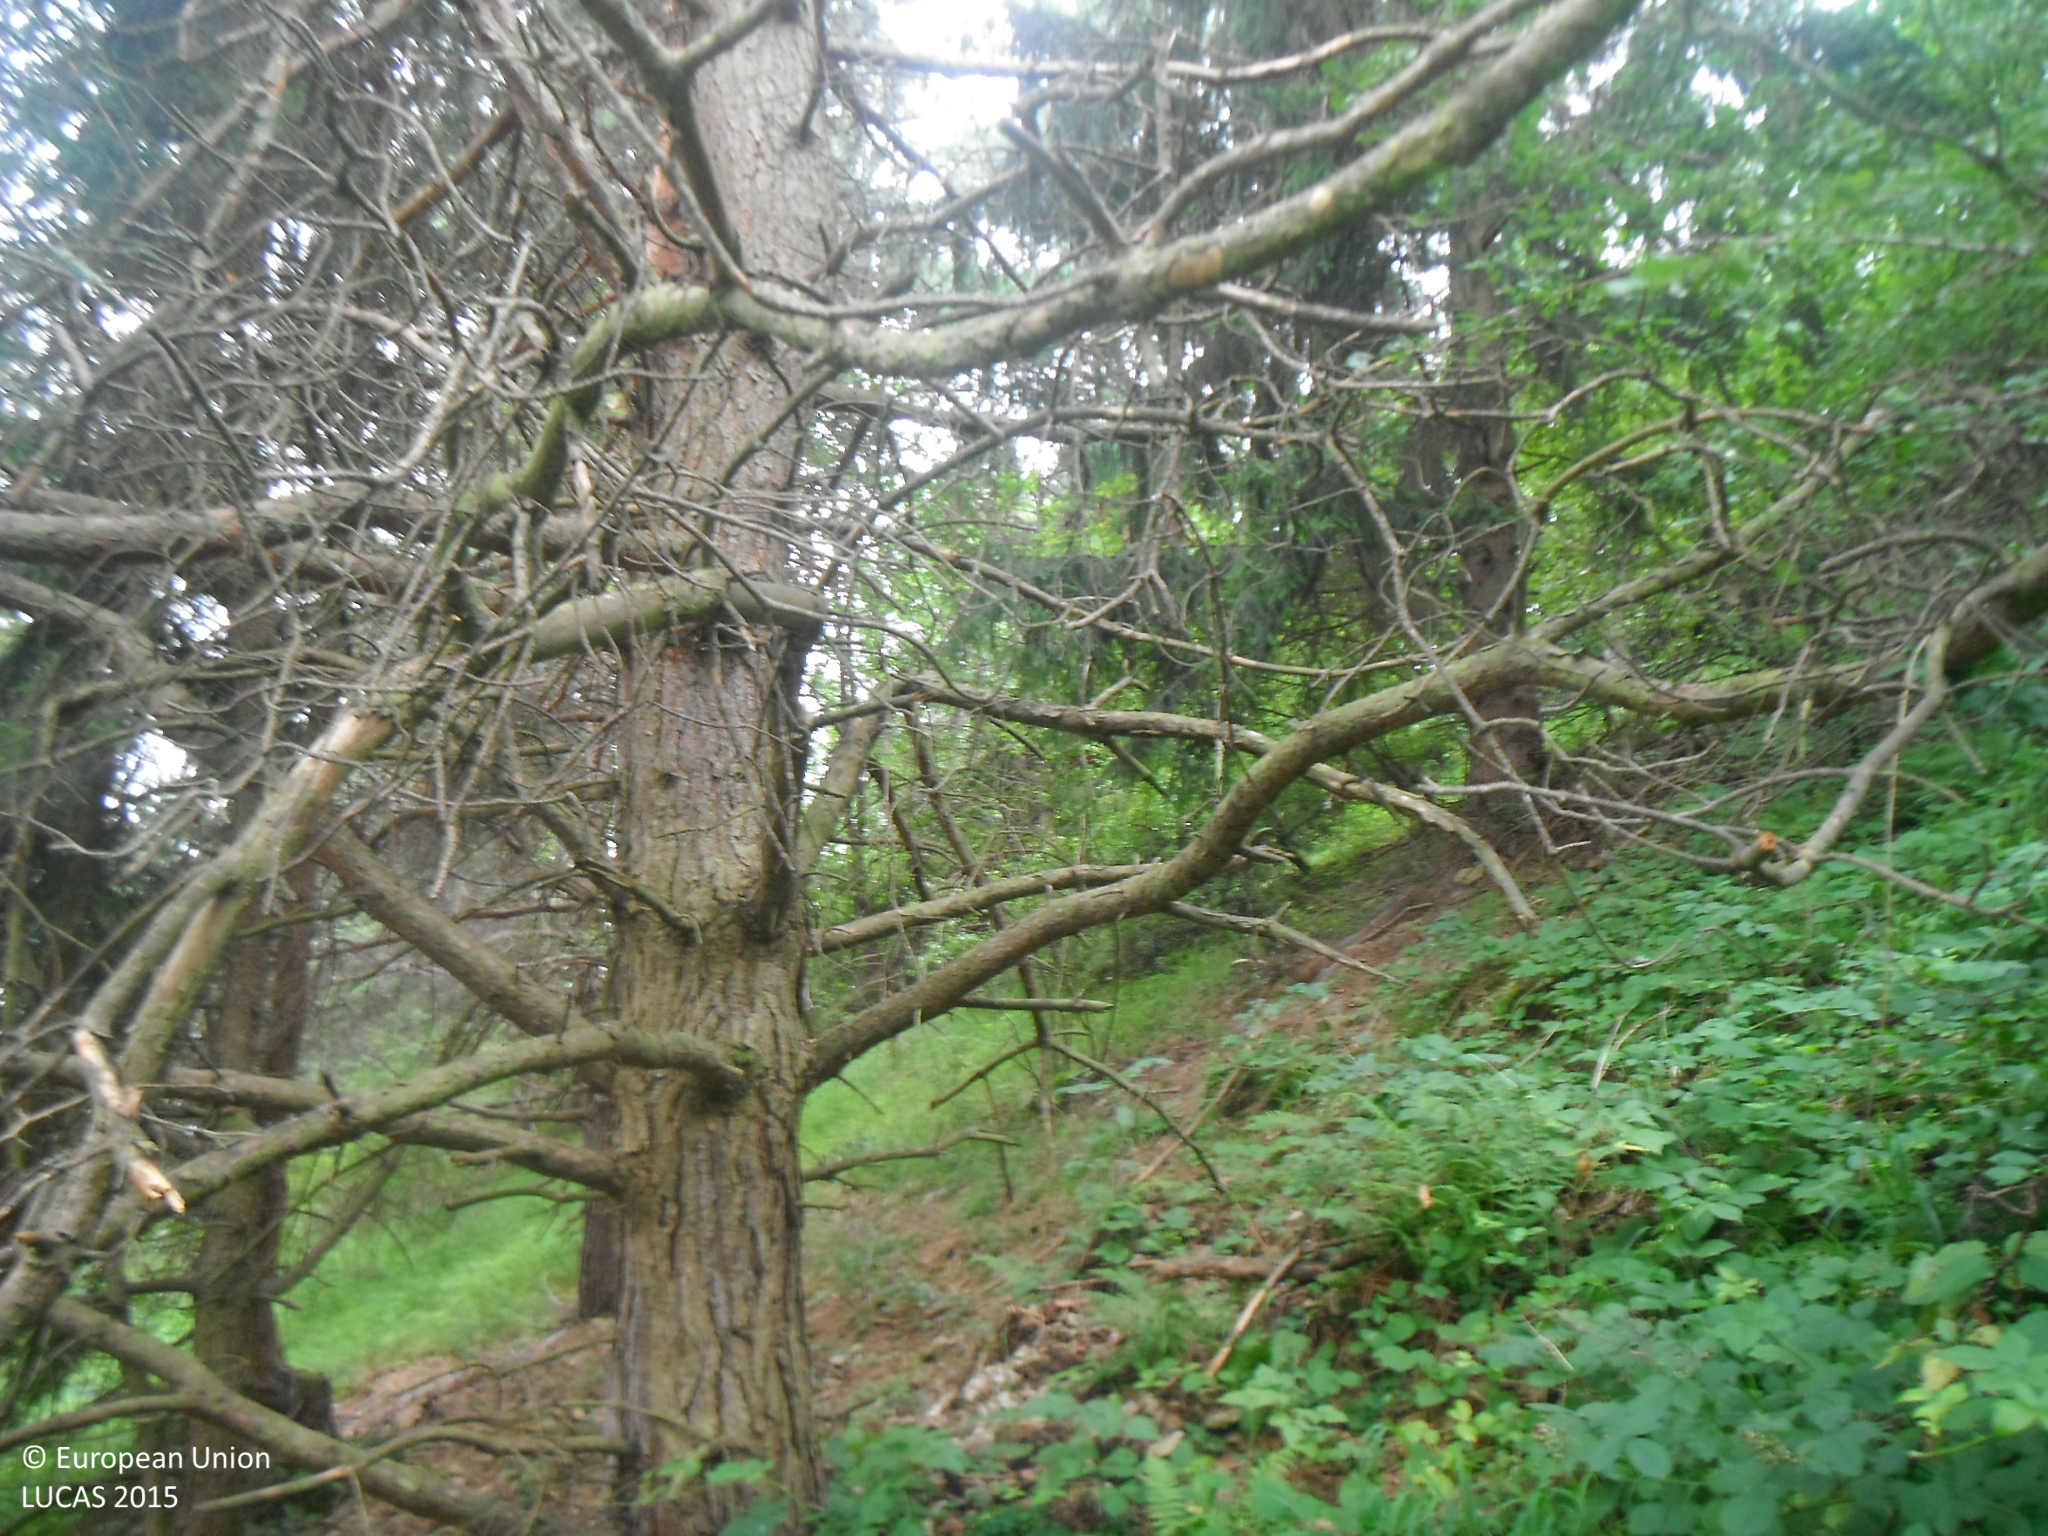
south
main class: Woodland
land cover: Pine dominated coniferous woodland
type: alpine coniferous forest
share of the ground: > 75 %
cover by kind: coniferous forest trees 75 %, herbaceous plants 15 %, shrubs 10 %
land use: Forestry
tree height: > 5 m
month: July
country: SK
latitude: 49.2403
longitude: 18.4097
